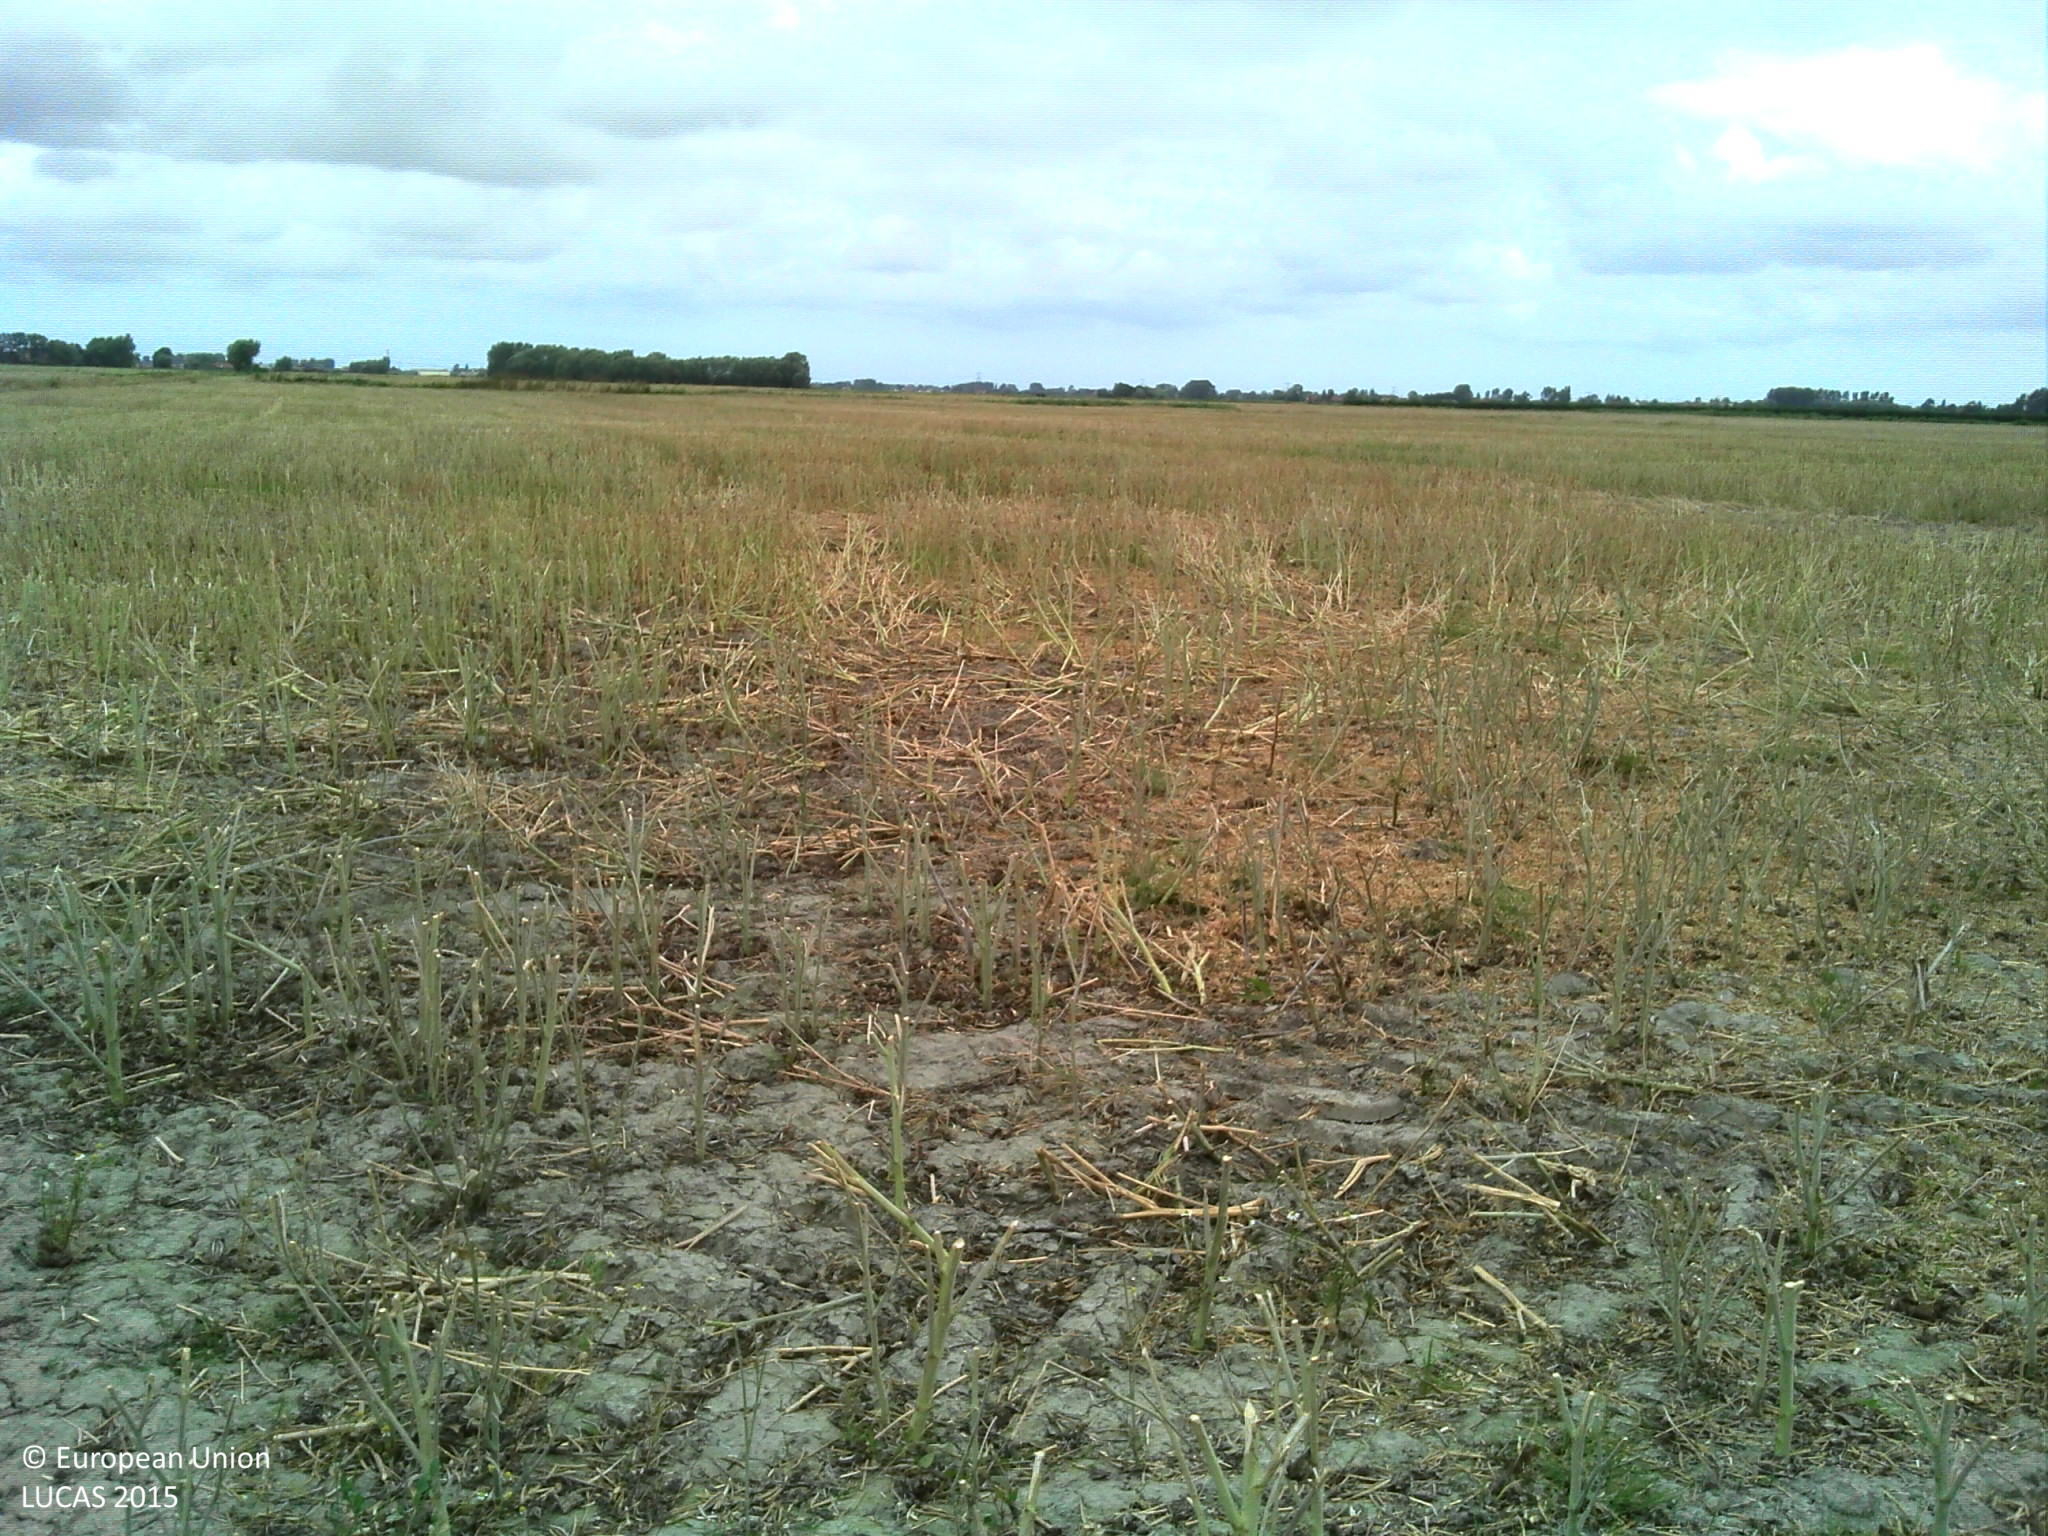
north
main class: Cropland
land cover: Rape and turnip rape
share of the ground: 10 - 25 %
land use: Agriculture (excluding fallow land and kitchen gardens)
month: August
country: FR
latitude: 50.9031
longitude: 2.0926
